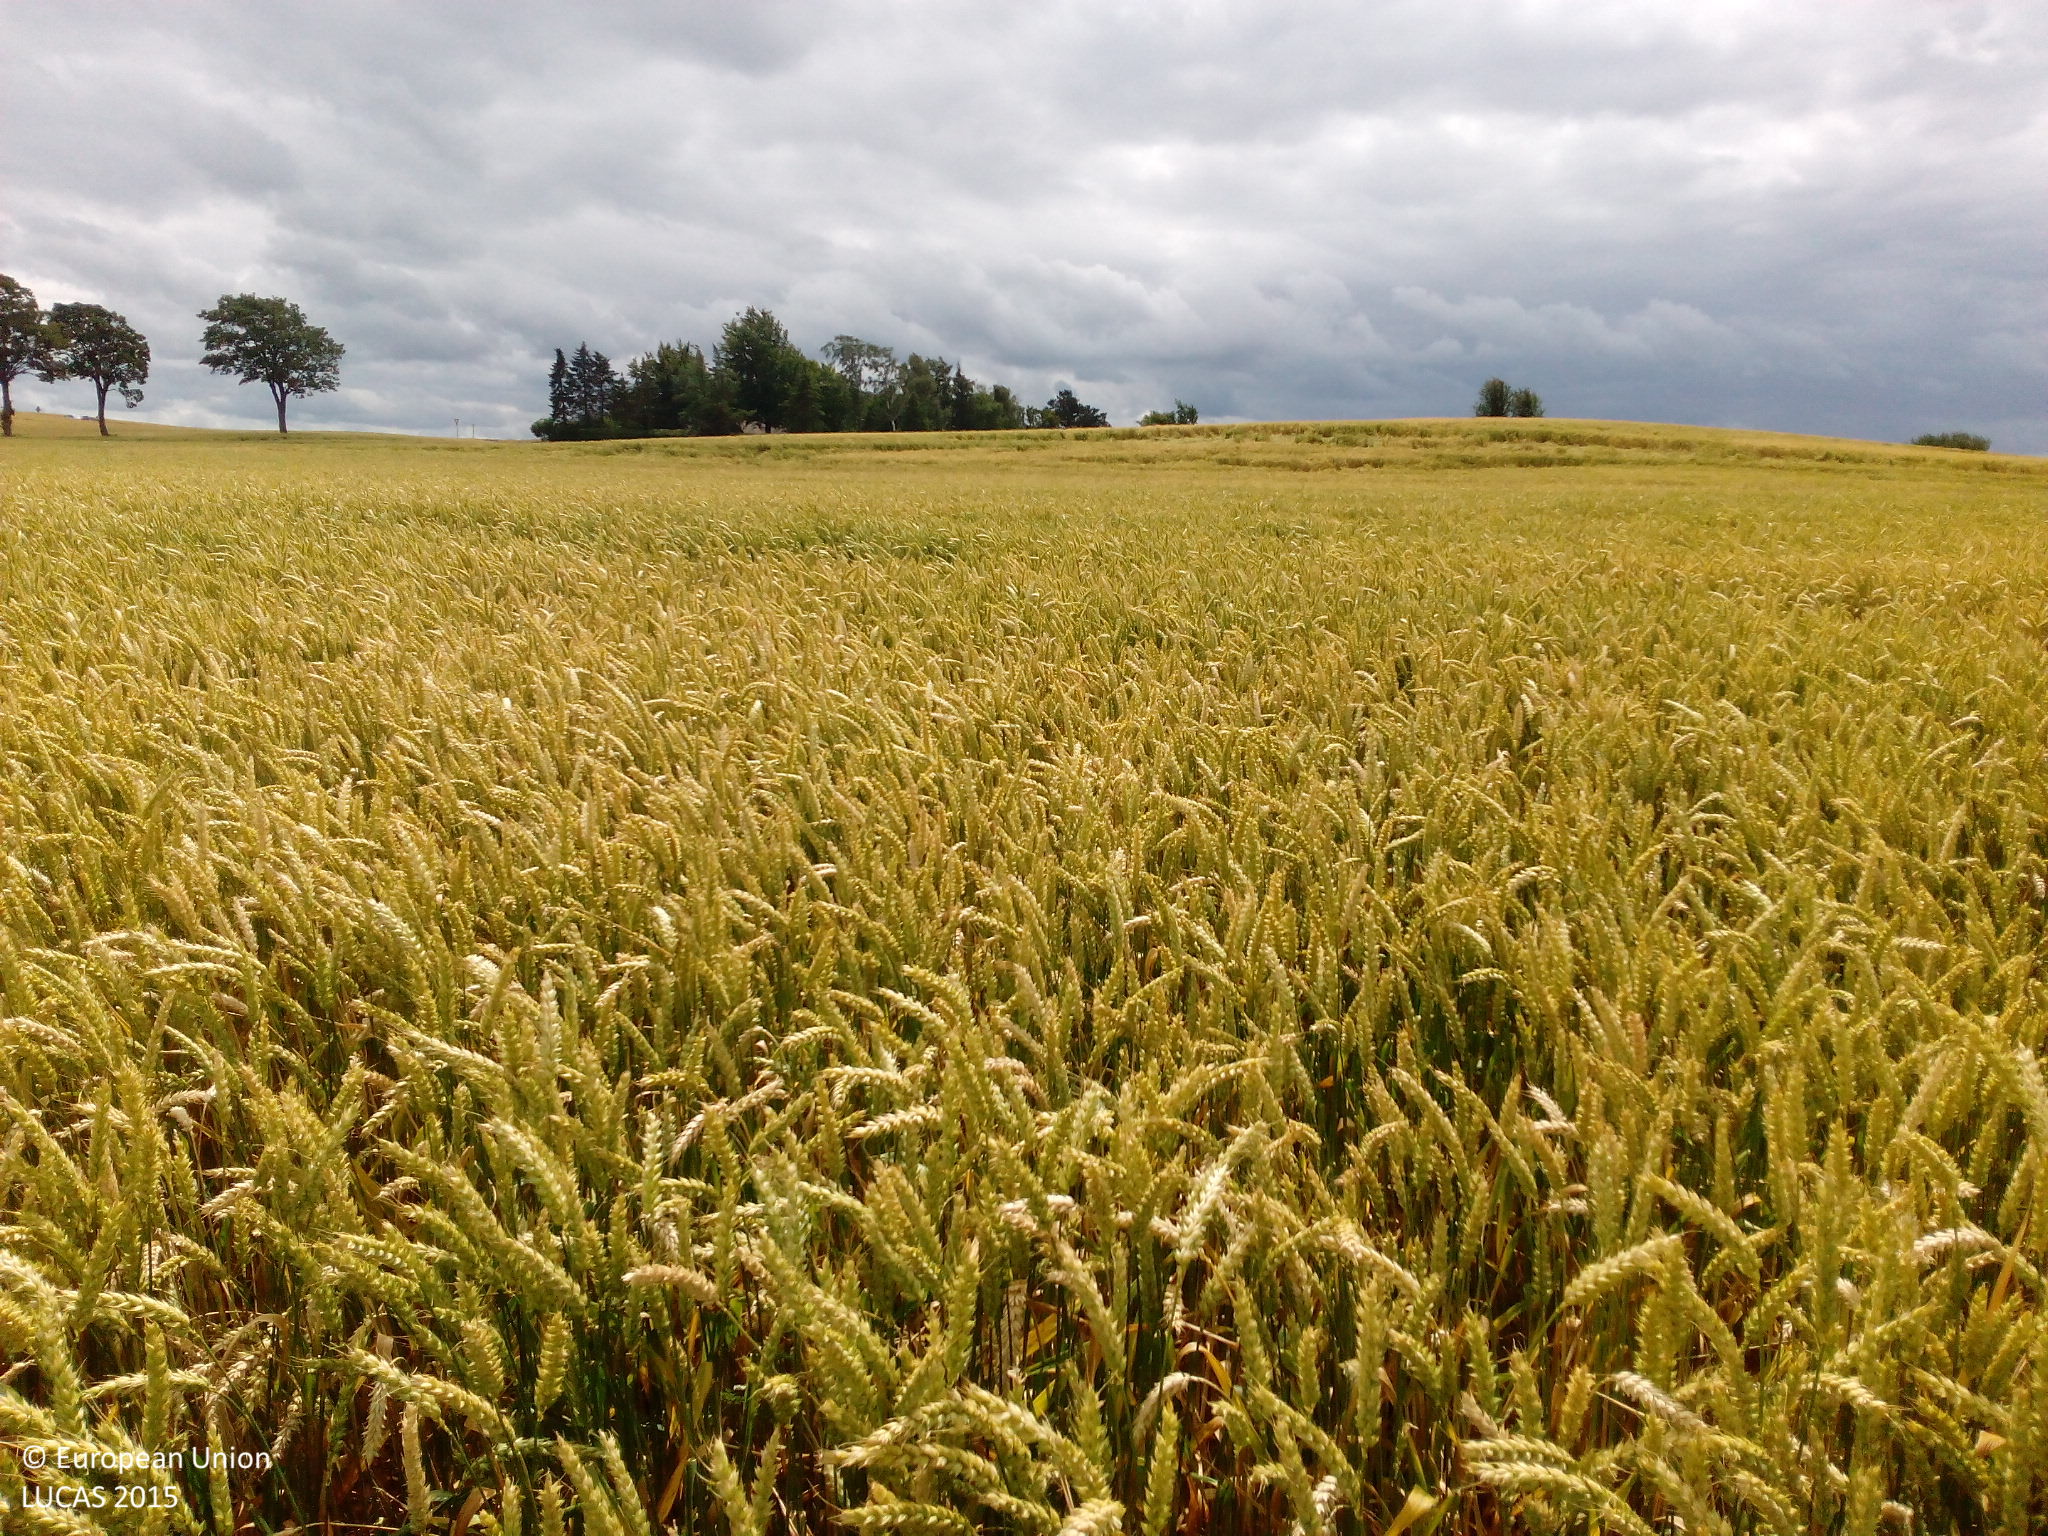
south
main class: Cropland
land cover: Common wheat
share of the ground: > 75 %
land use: Agriculture (excluding fallow land and kitchen gardens)
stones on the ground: < 10 %
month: July
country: DK
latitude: 55.9897
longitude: 12.1620
